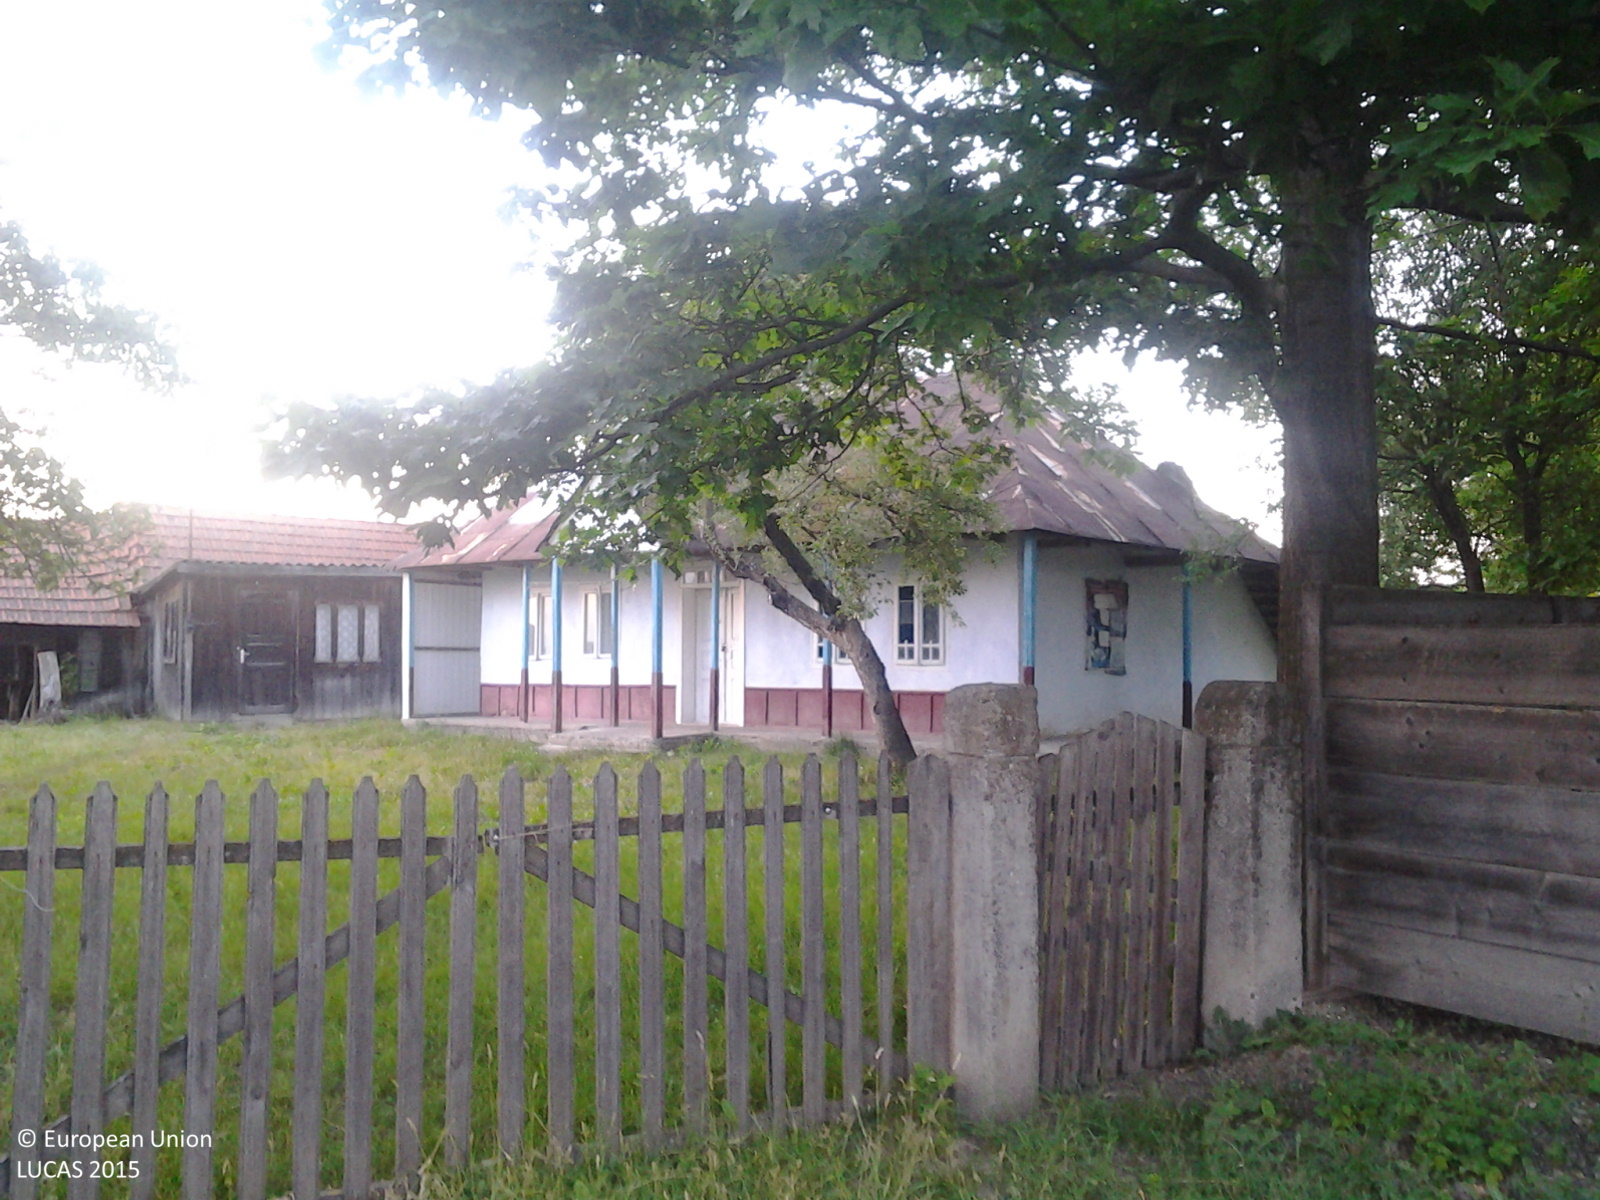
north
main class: Grassland
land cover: Grassland without tree/shrub cover
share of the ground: > 75 %
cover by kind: herbaceous plants 100 %
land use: Agriculture (excluding fallow land and kitchen gardens)
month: June
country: RO
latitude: 47.7430
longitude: 26.4807
